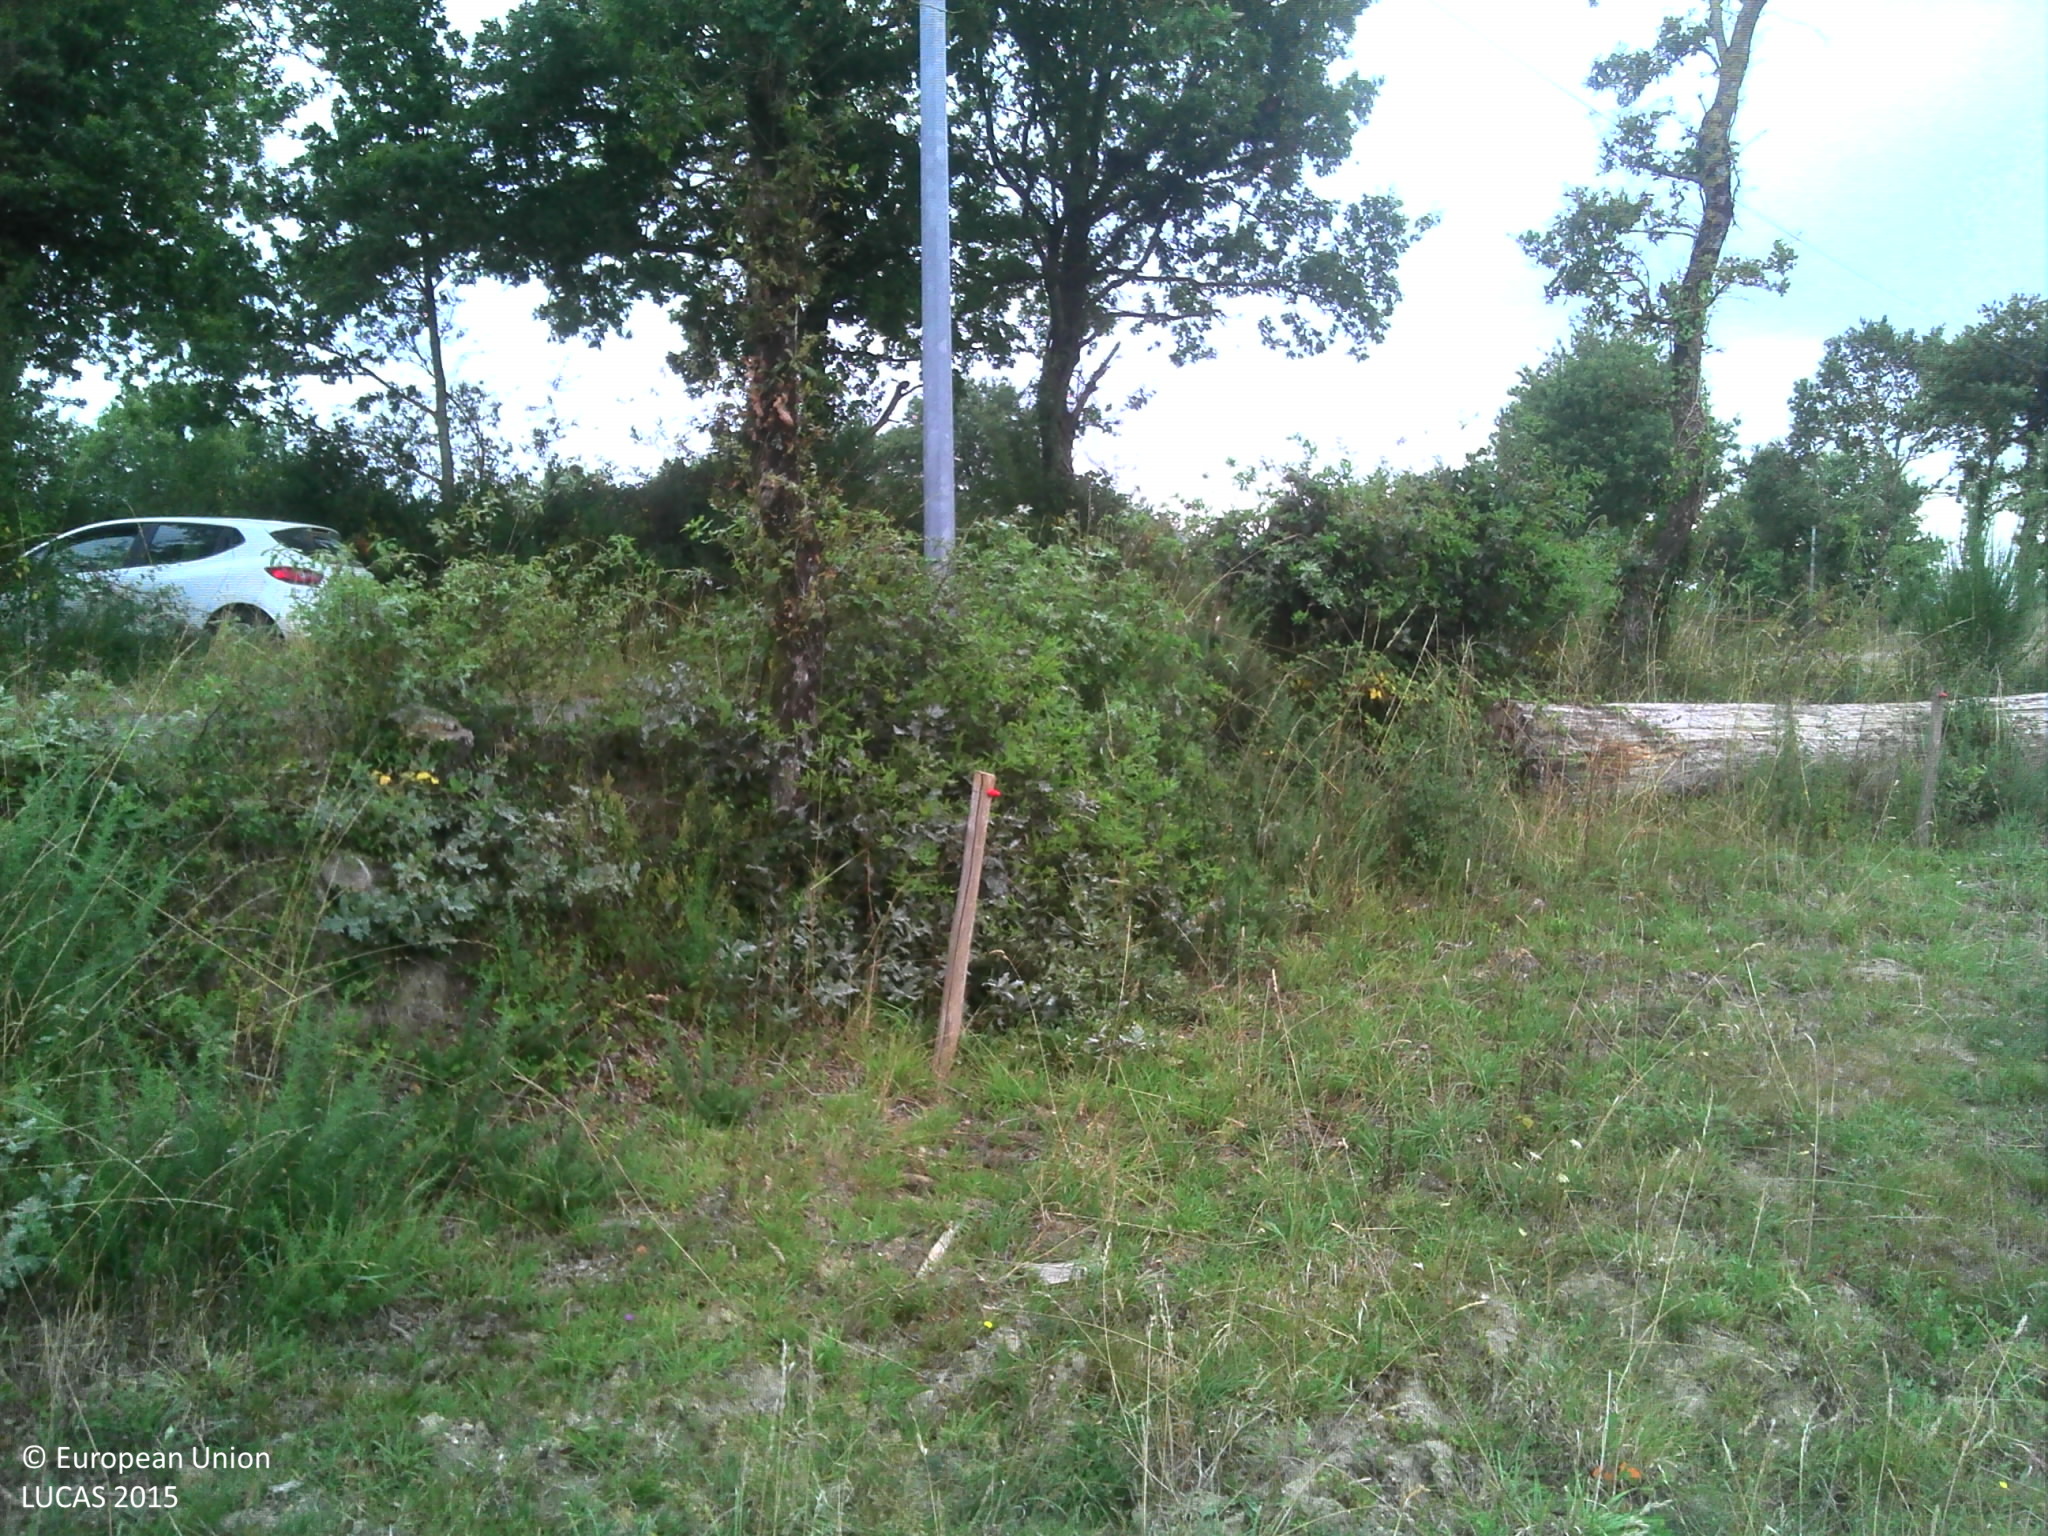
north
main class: Grassland
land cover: Grassland without tree/shrub cover
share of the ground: > 75 %
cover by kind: herbaceous plants 100 %
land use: Agriculture (excluding fallow land and kitchen gardens)
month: August
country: FR
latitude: 46.7189
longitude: -1.5922
